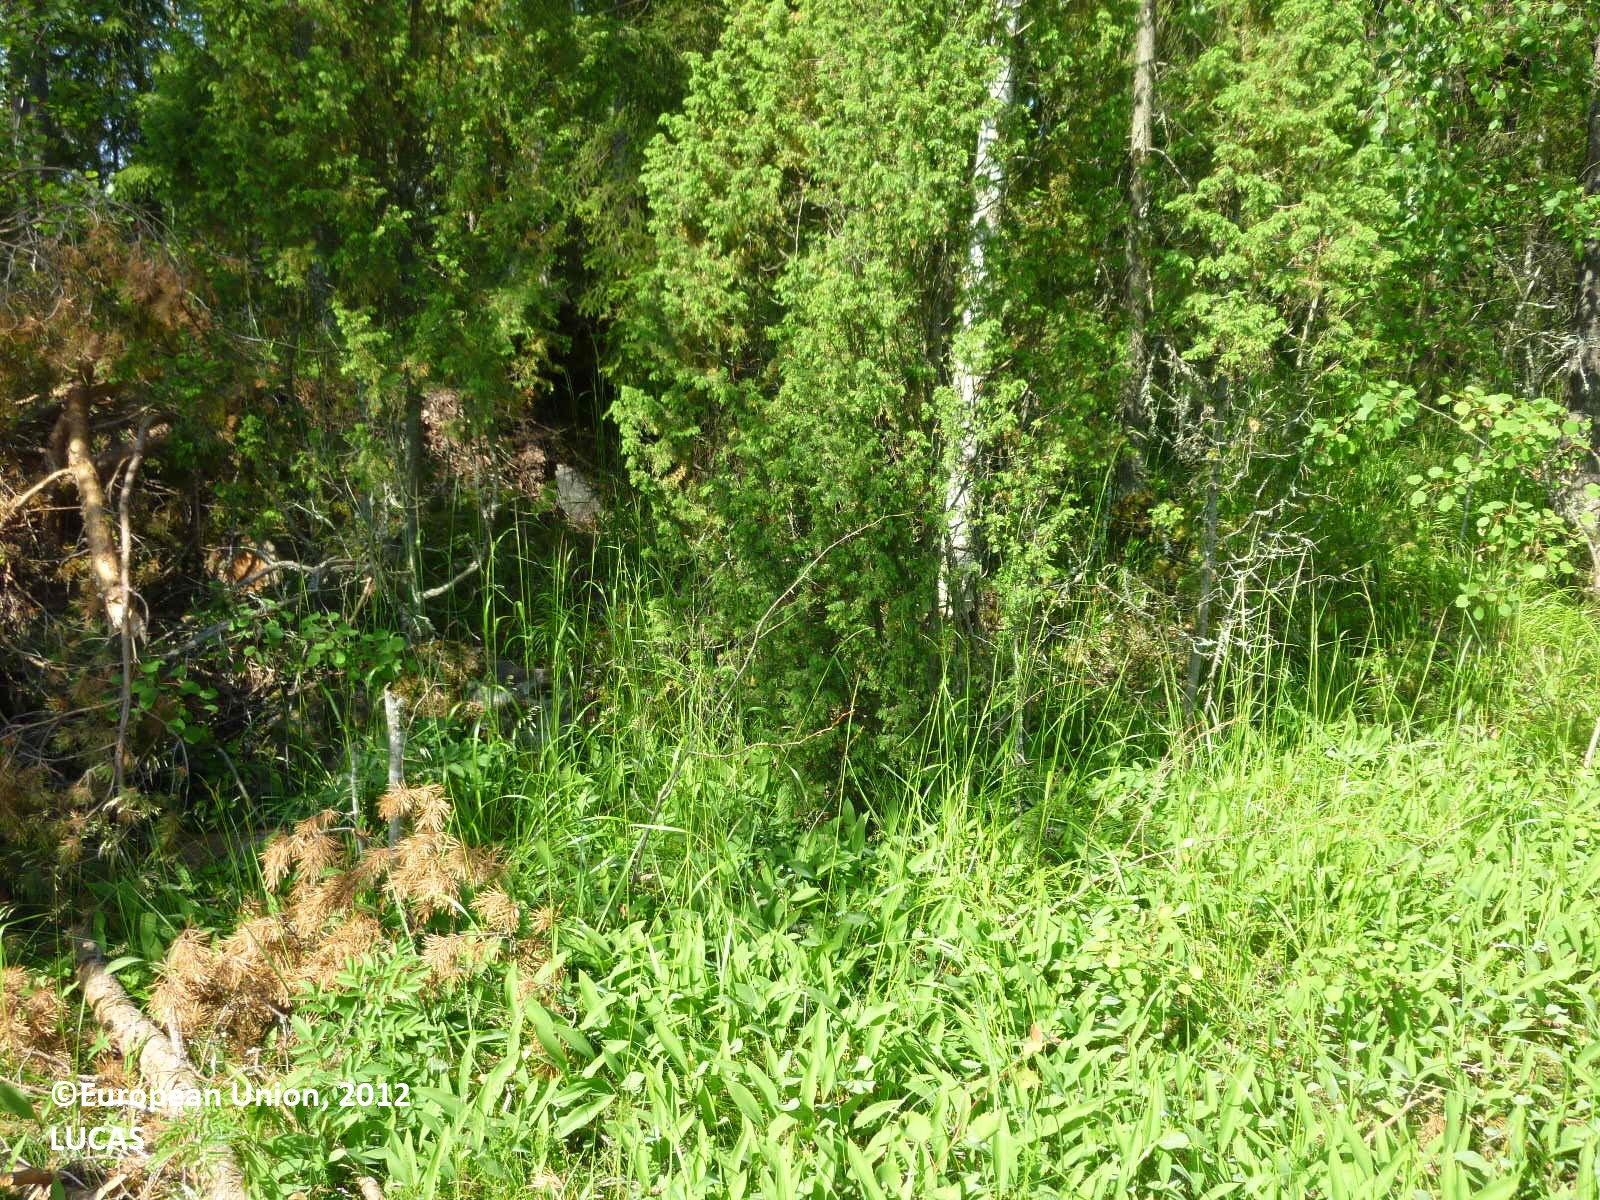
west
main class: Grassland
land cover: Grassland without tree/shrub cover
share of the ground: > 75 %
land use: Road transport
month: July
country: FI
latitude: 61.2545
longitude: 22.4225
